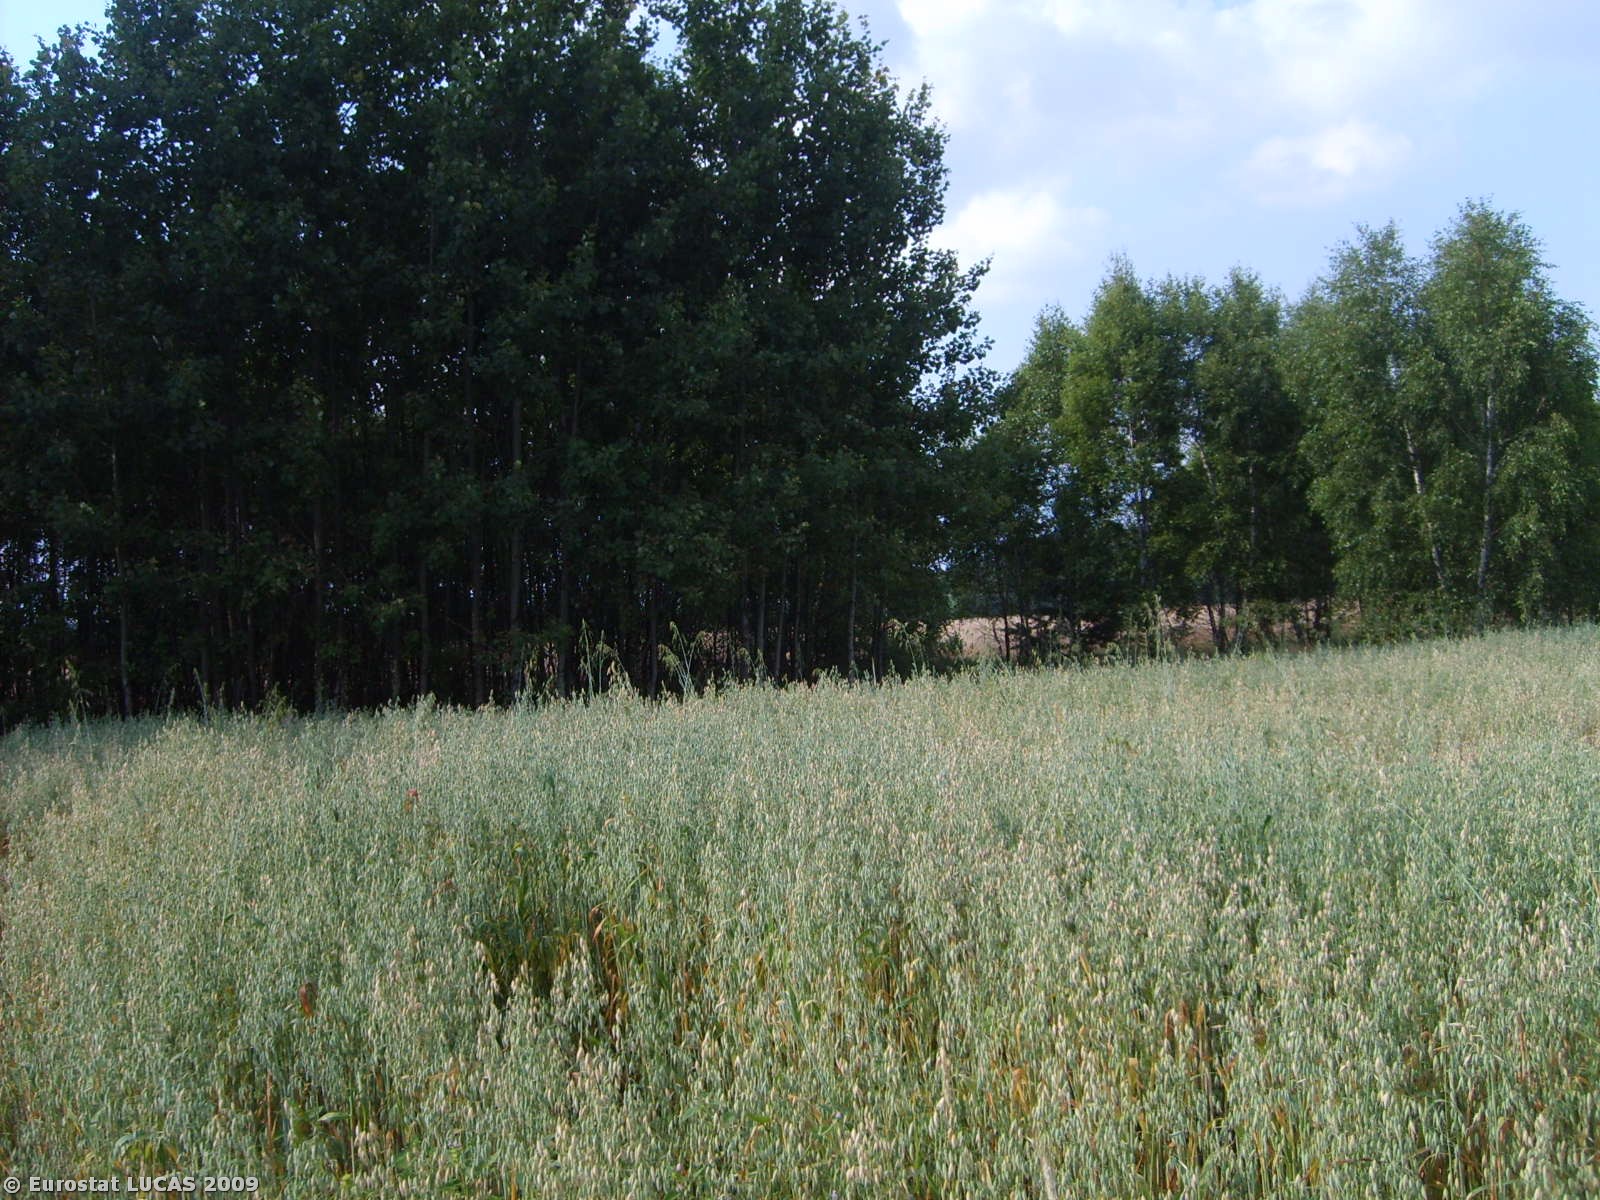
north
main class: Grassland
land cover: Grassland without tree/shrub cover
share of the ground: > 75 %
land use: Unused
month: July
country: PL
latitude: 52.4486
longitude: 21.7220
